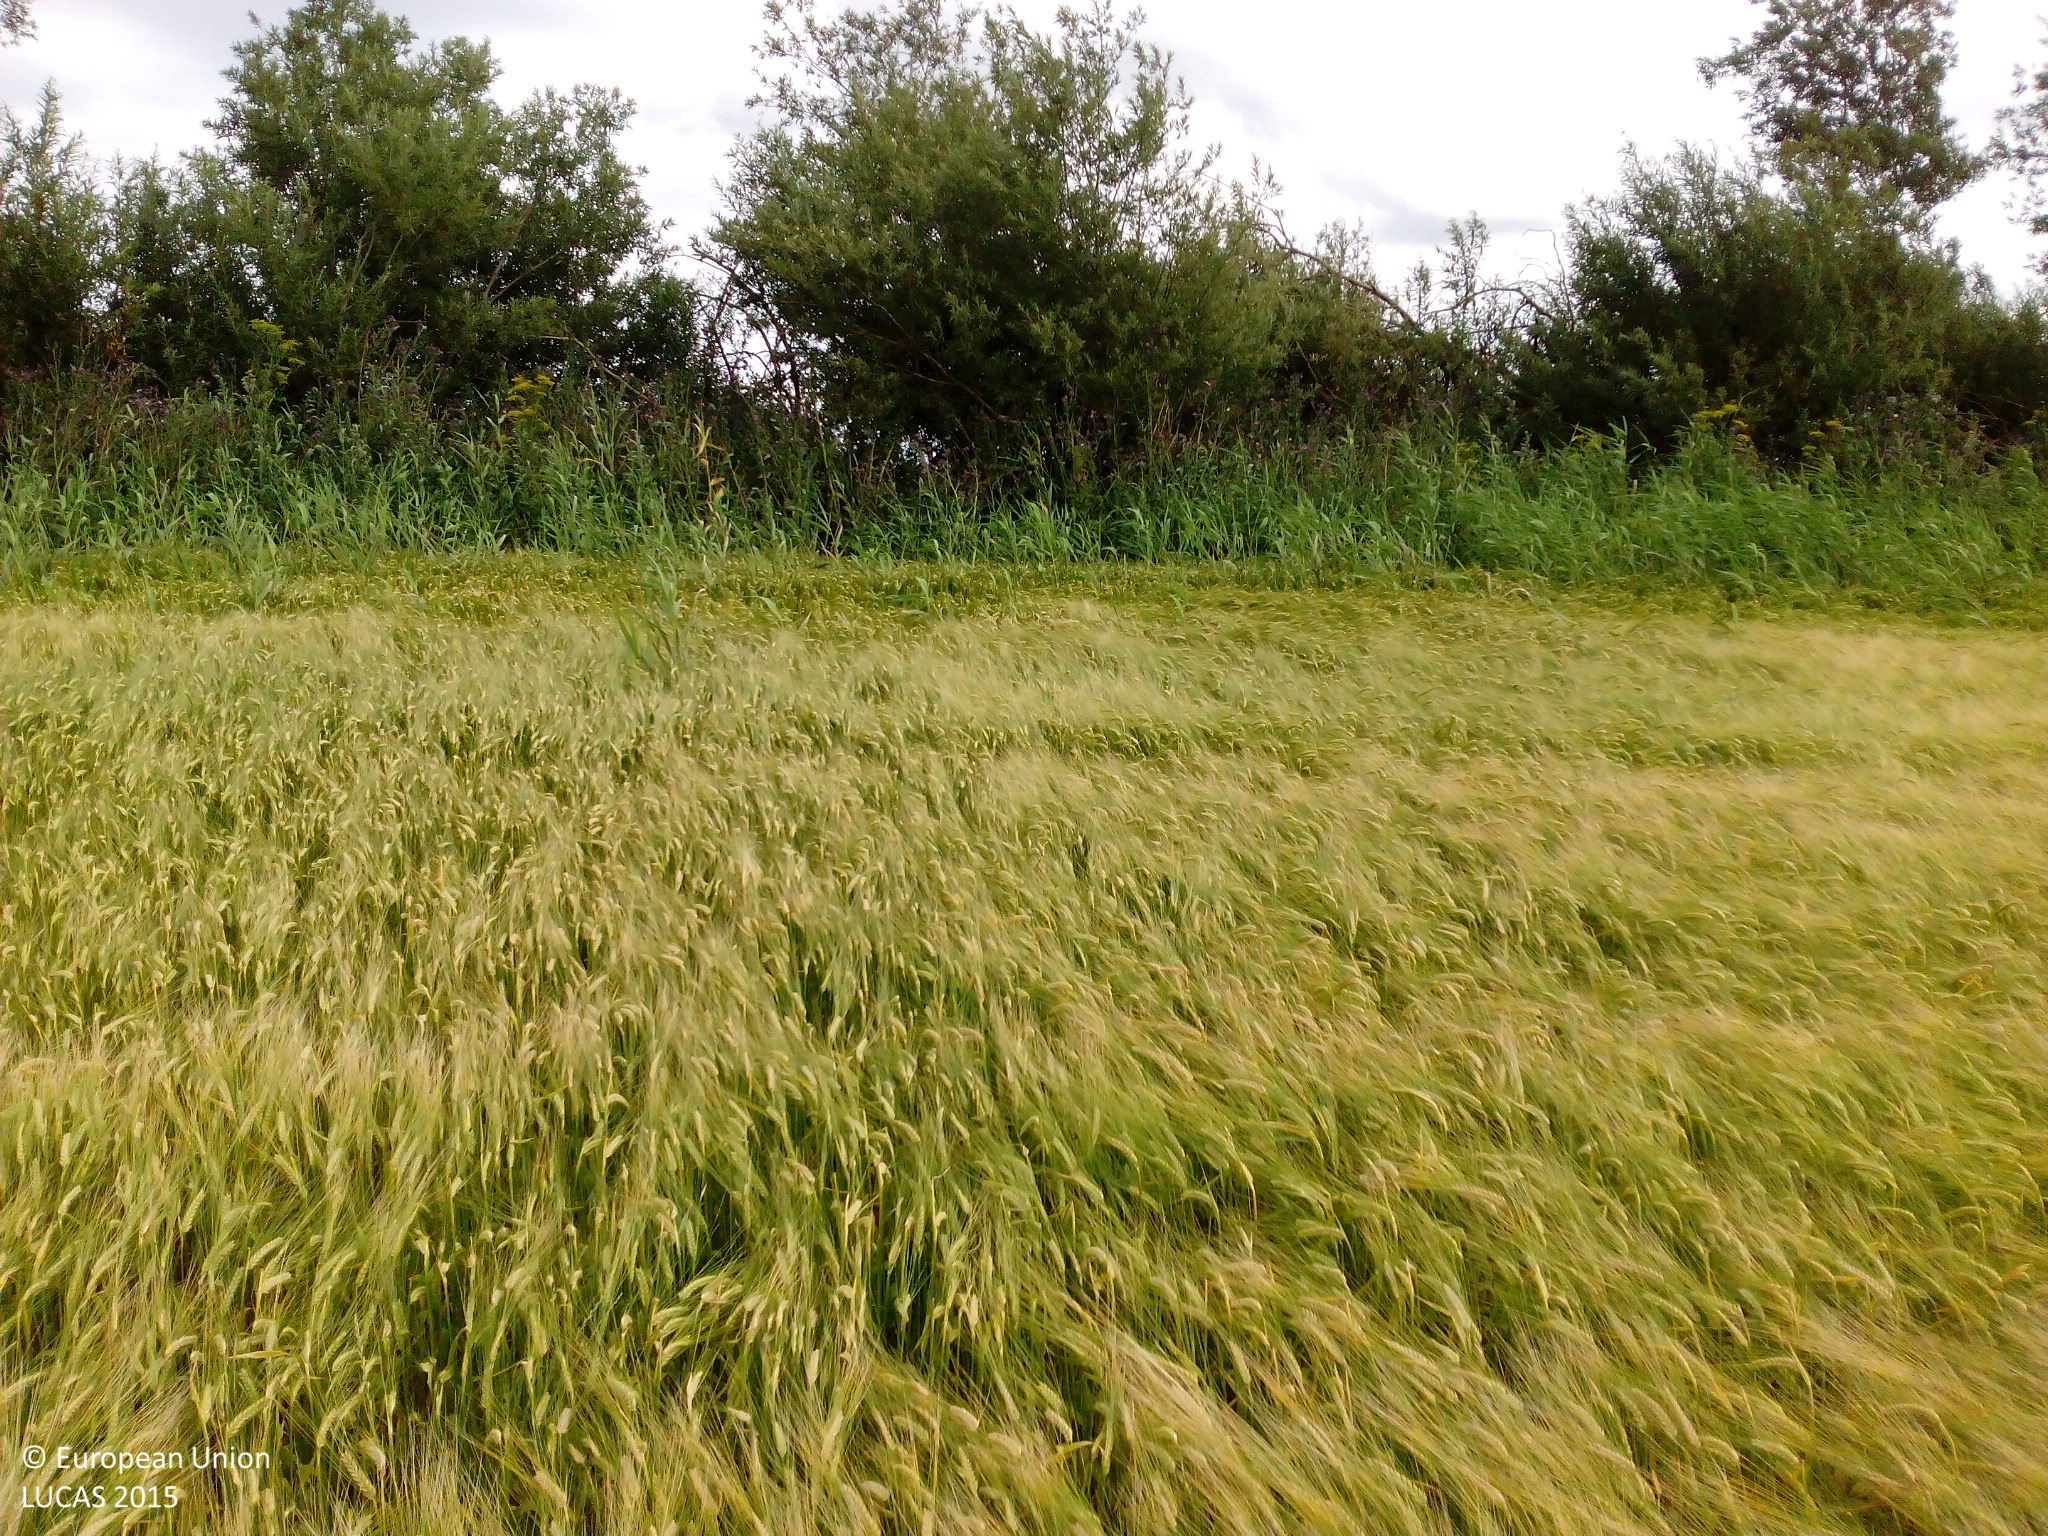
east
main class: Cropland
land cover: Barley
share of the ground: > 75 %
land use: Agriculture (excluding fallow land and kitchen gardens)
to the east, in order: Barley; Broadleaved woodland; Shruby margins; Rape and turnip rape
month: July
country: DK
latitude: 55.6931
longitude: 11.5417
